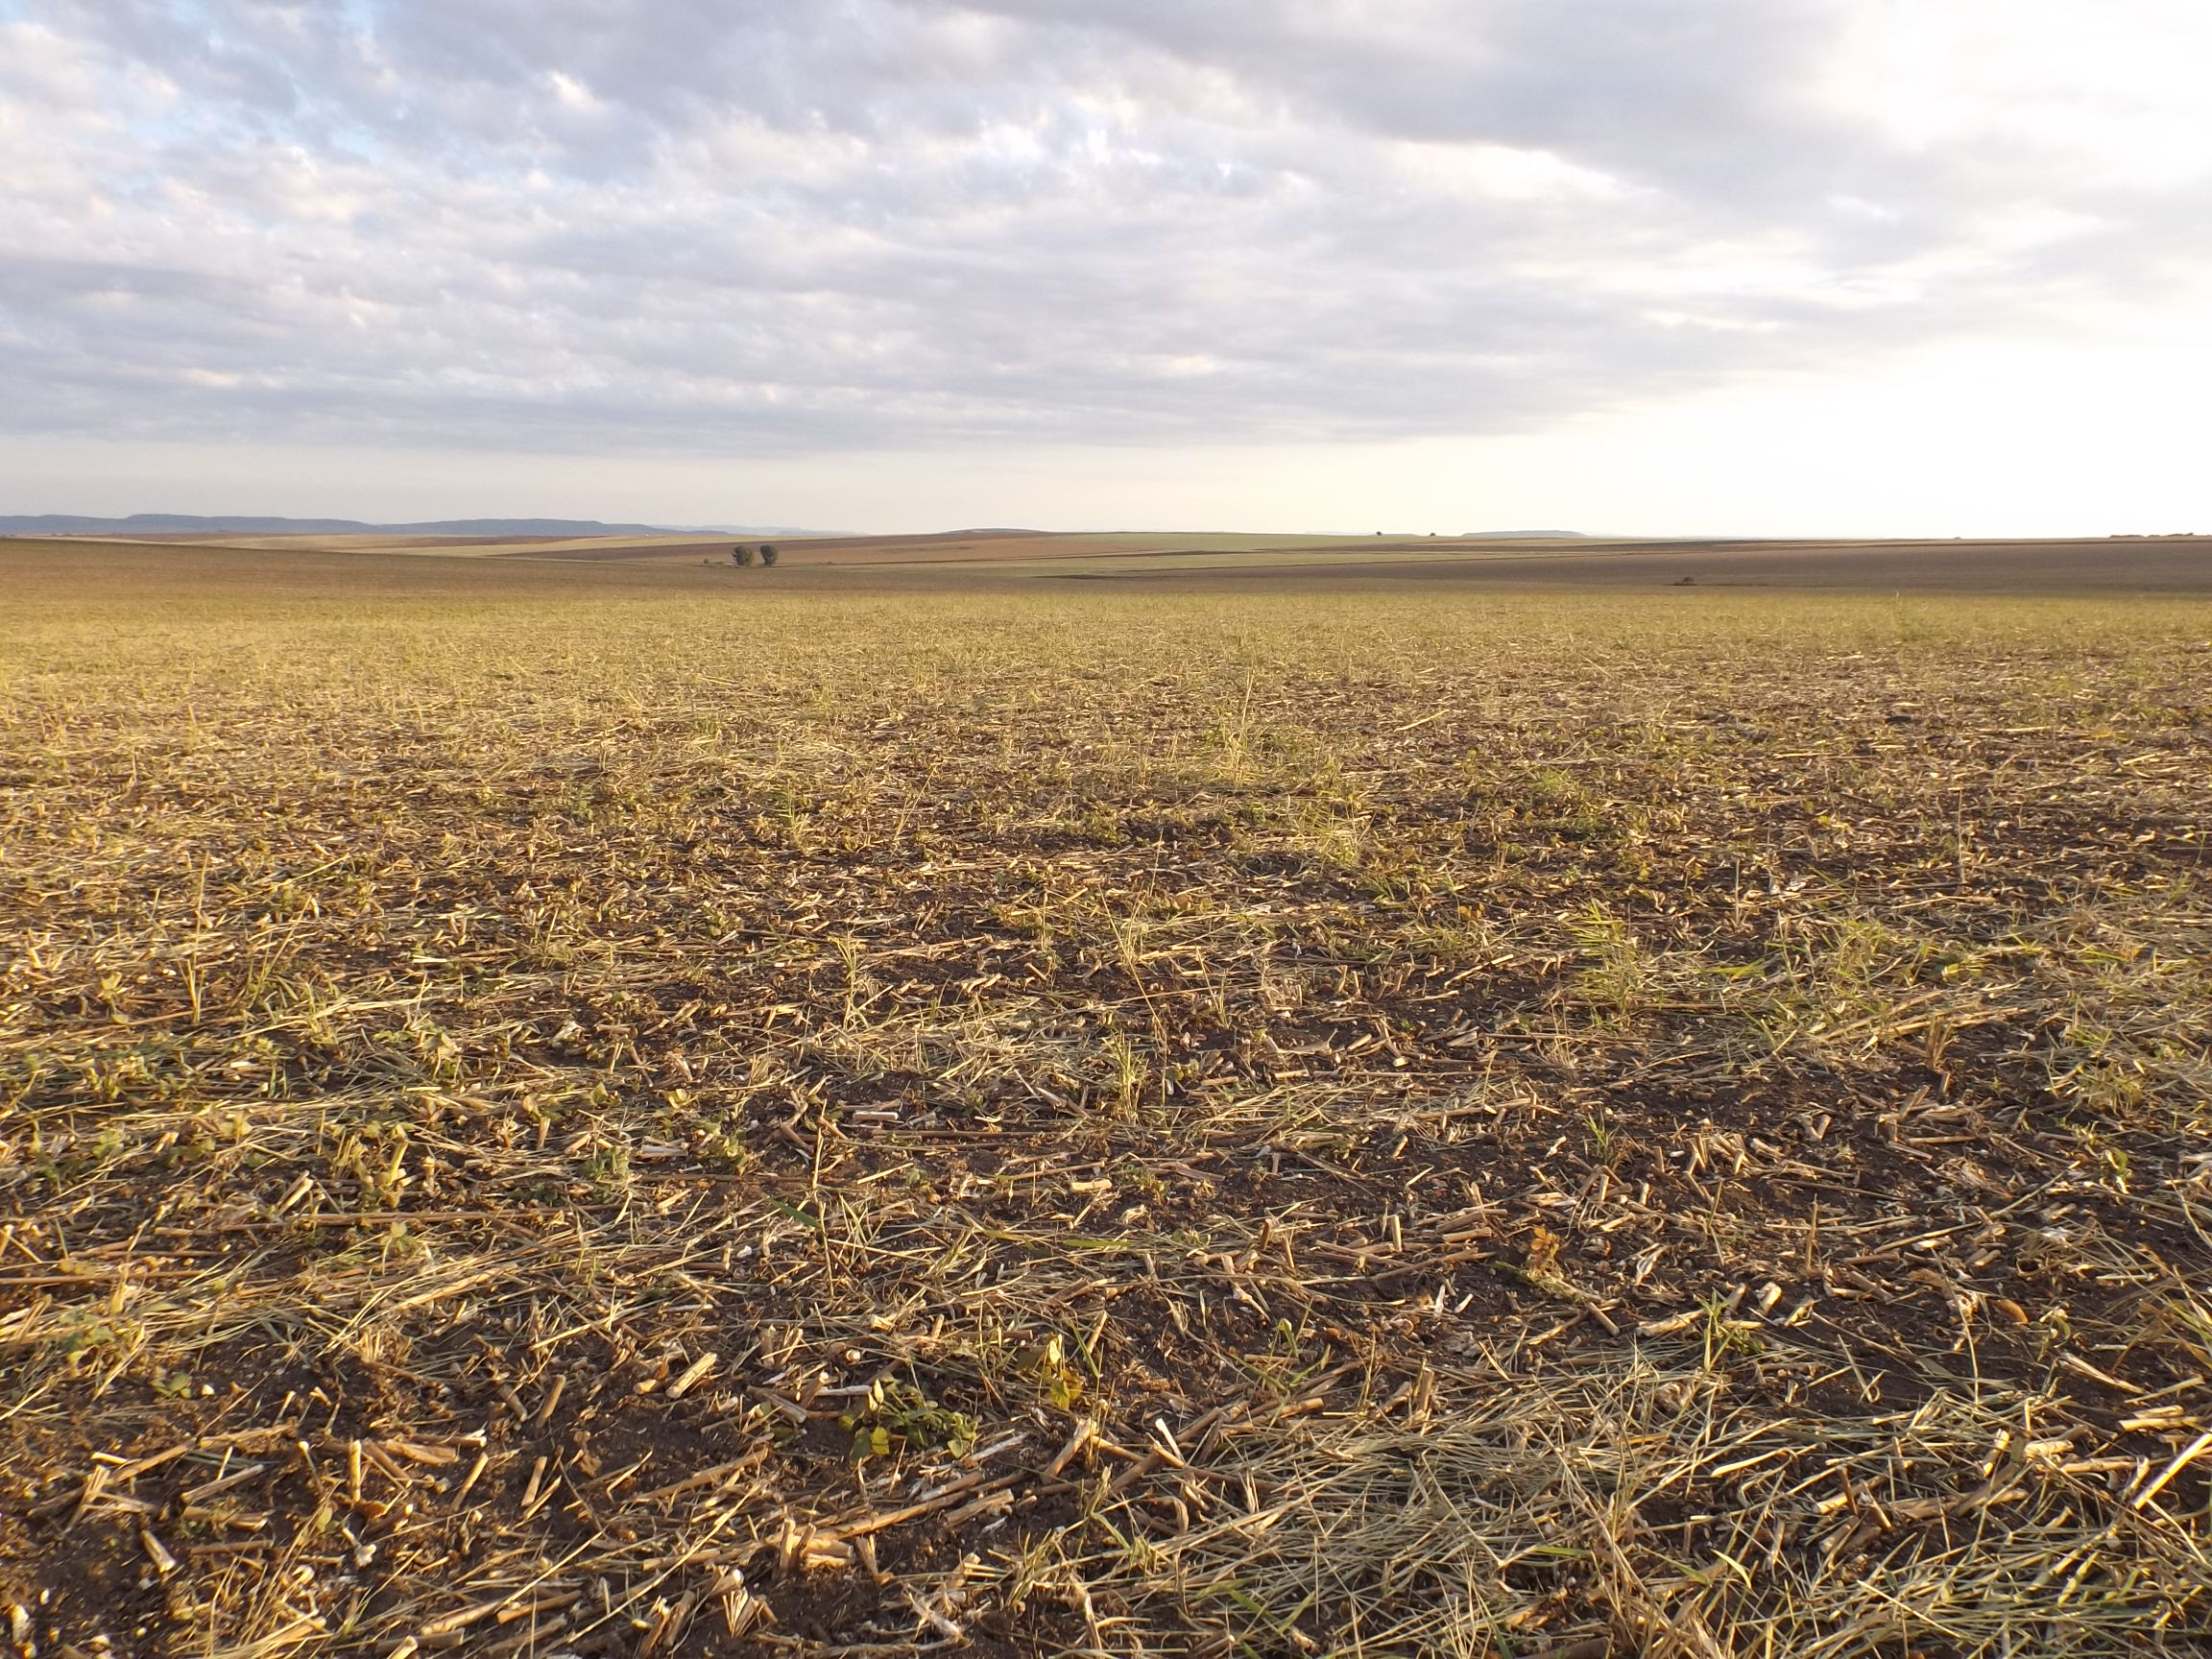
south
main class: Cropland
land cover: Sunflower
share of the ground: < 10 %
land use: Agriculture (excluding fallow land and kitchen gardens)
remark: Harvested field
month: September
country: BG
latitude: 43.3748
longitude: 27.4437
